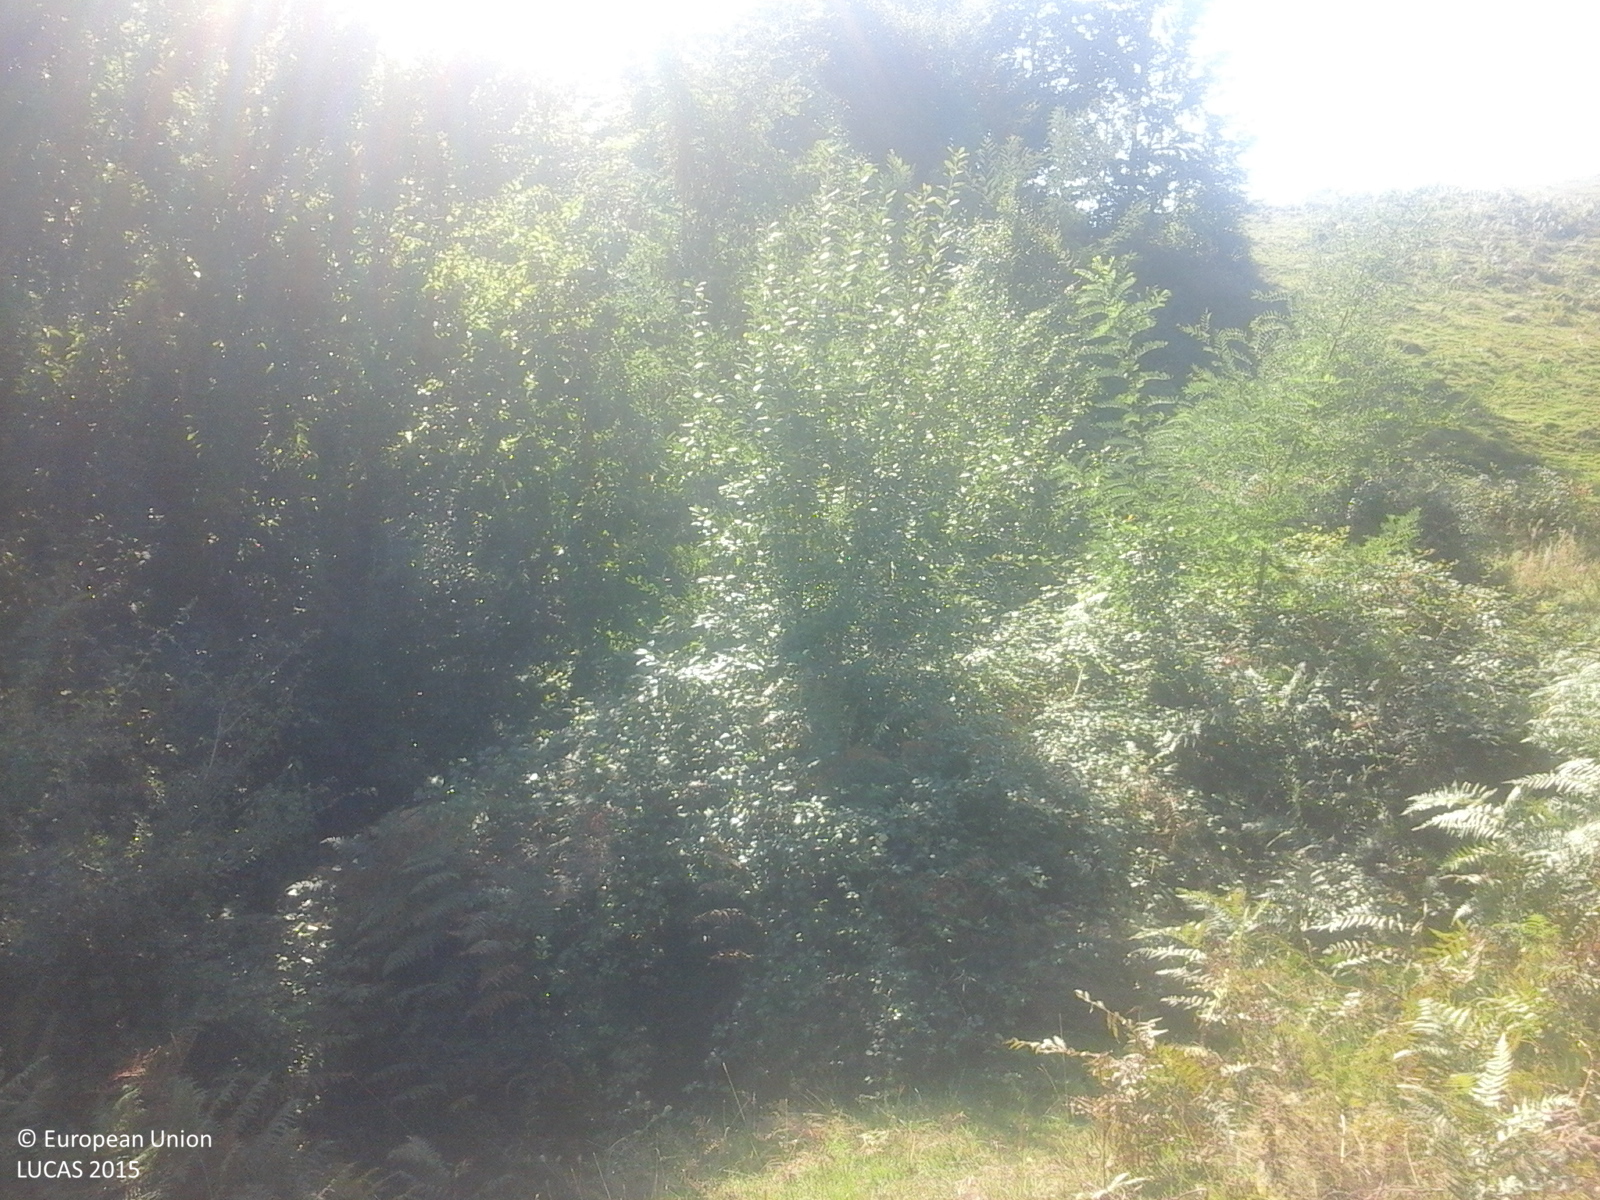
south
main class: Grassland
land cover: Grassland without tree/shrub cover
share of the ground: > 75 %
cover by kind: herbaceous plants 100 %
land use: Agriculture (excluding fallow land and kitchen gardens)
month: September
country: RO
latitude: 46.8121
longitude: 22.3836
